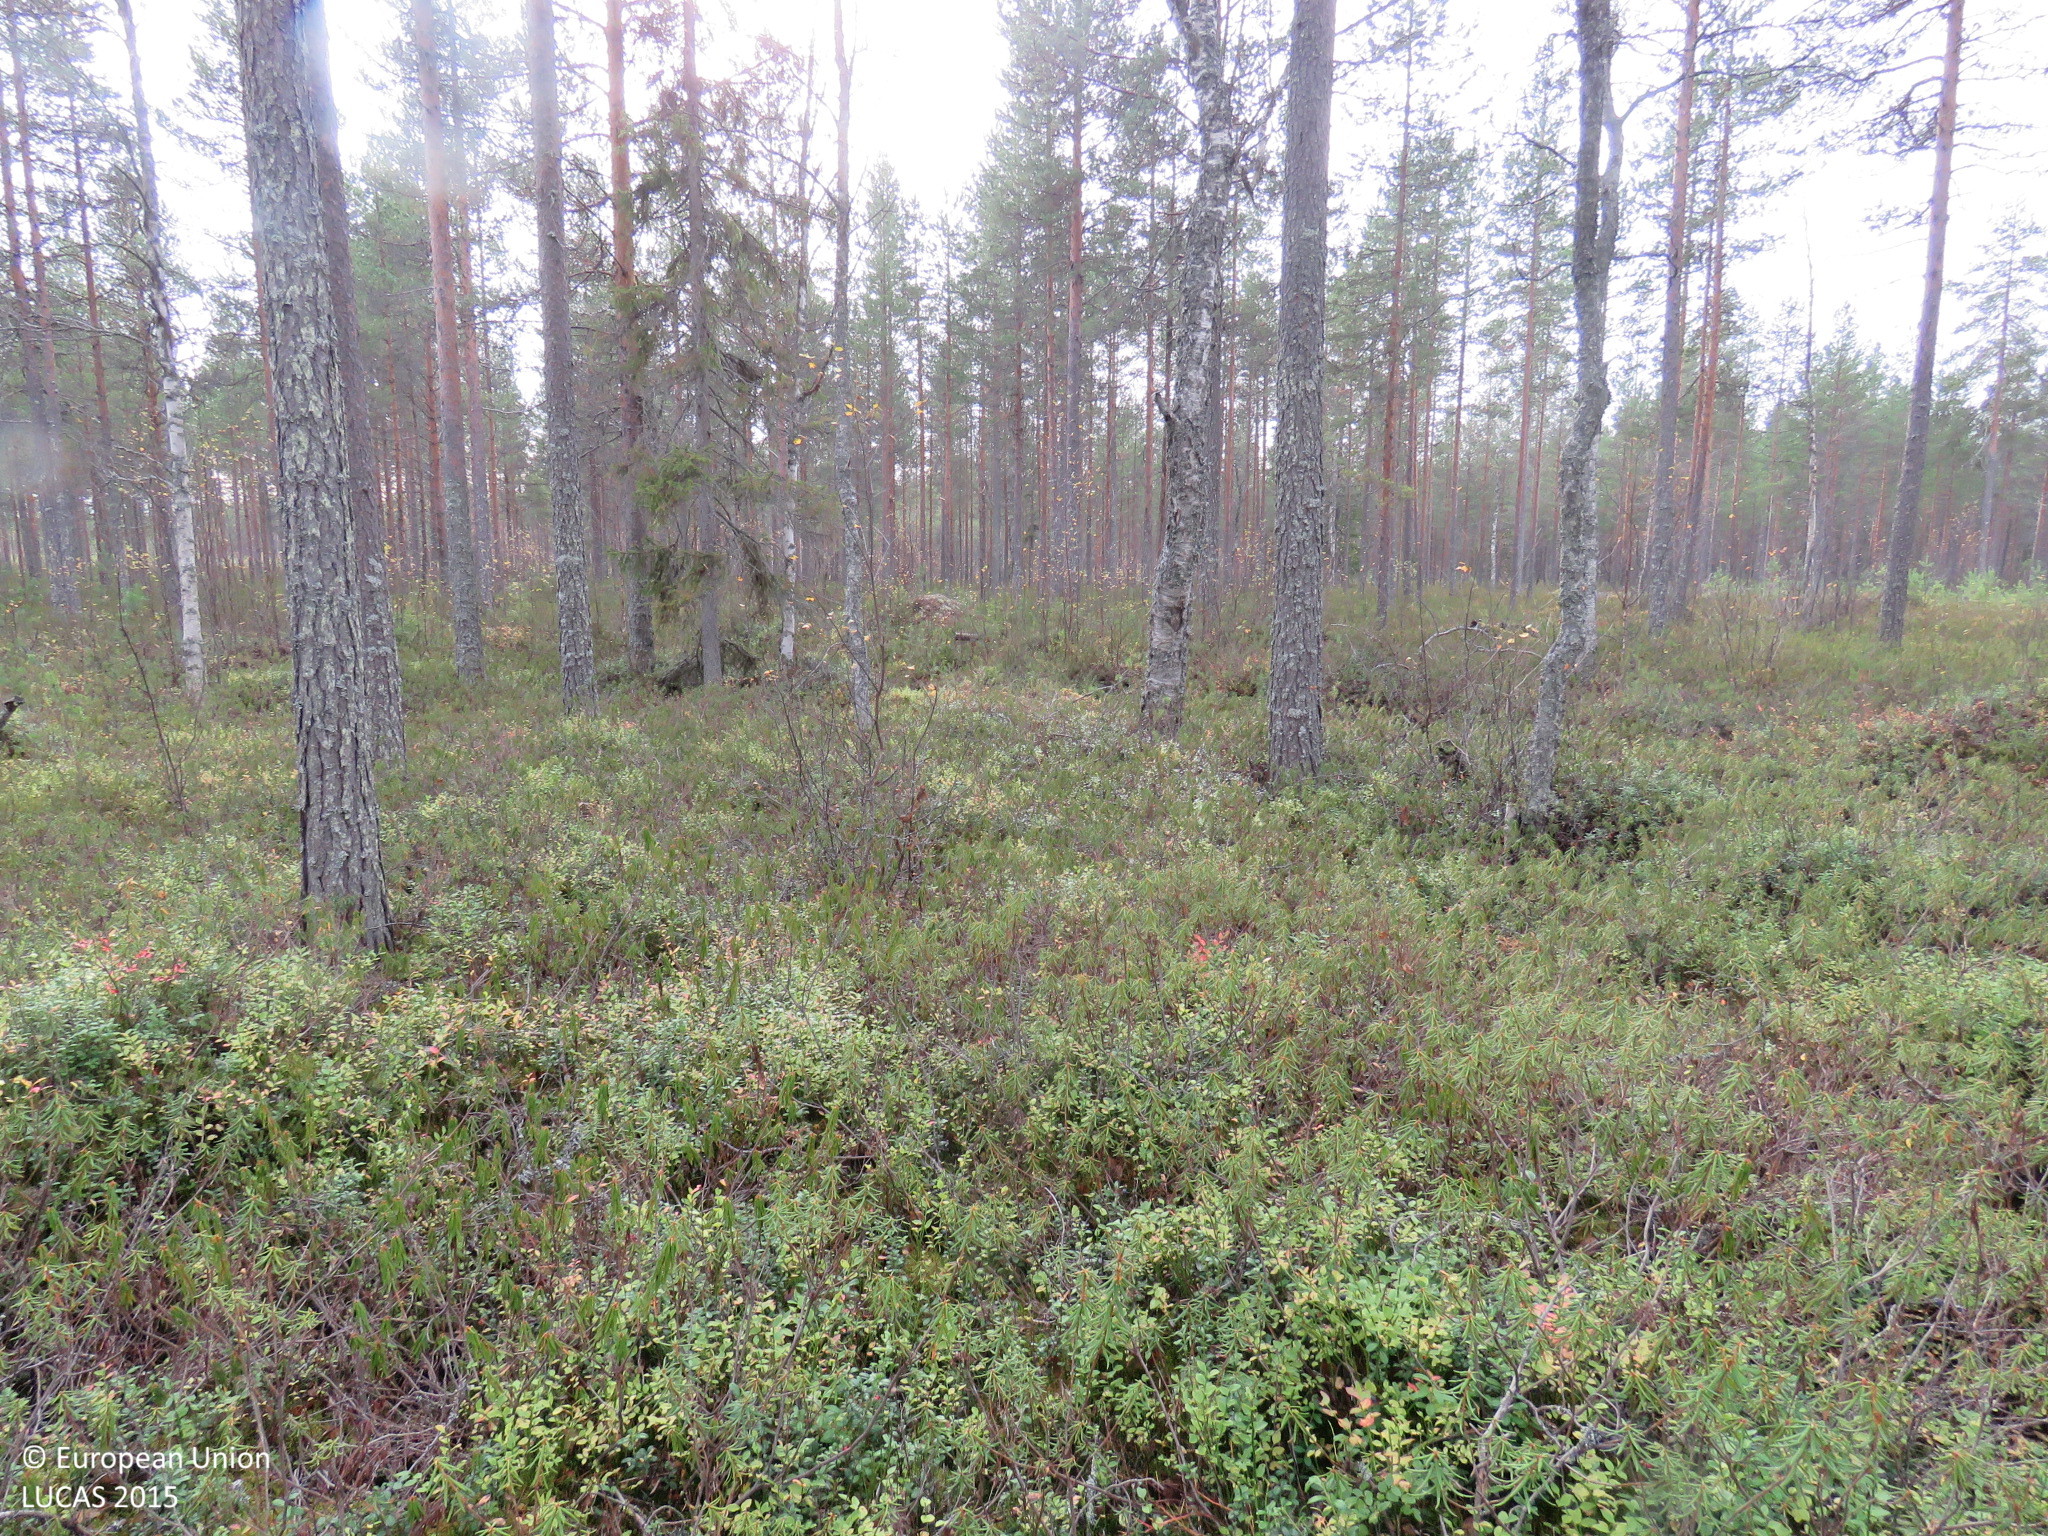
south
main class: Woodland
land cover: Pine dominated coniferous woodland
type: boreal forest
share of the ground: 50 - 75 %
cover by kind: coniferous forest trees 60 %, shrubs 25 %, broadleaved forest trees 10 %, lichens and mosses 5 %
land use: Forestry
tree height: > 5 m
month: September
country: FI
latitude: 64.9656
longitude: 27.2639
